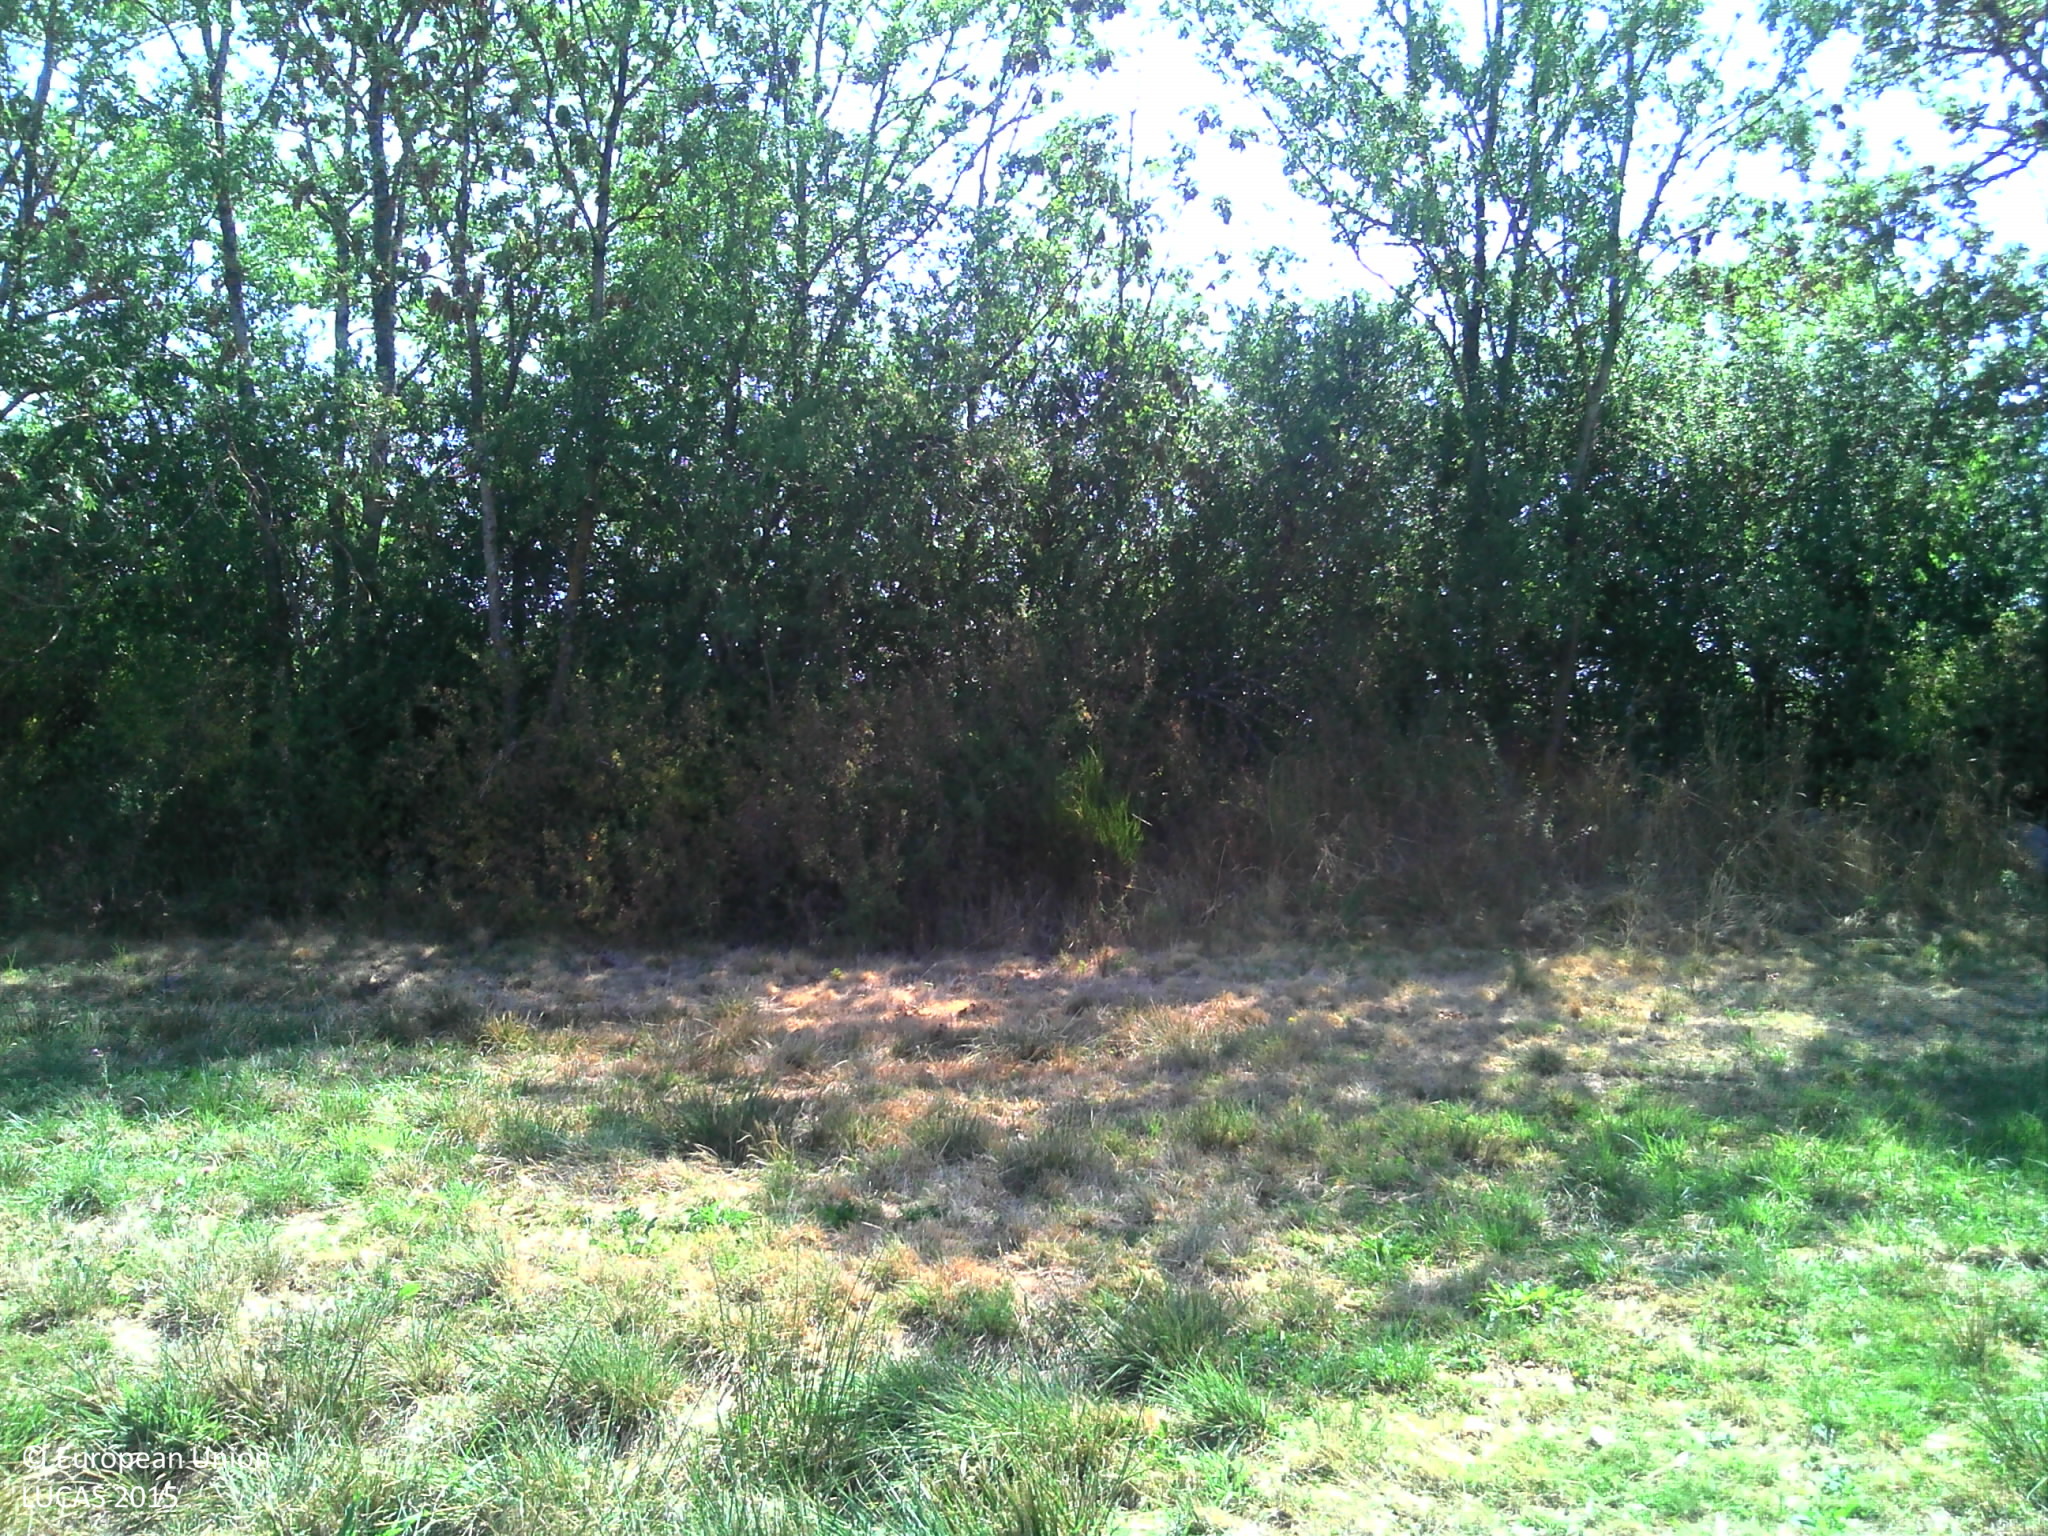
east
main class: Grassland
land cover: Grassland without tree/shrub cover
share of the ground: > 75 %
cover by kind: herbaceous plants 100 %
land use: Agriculture (excluding fallow land and kitchen gardens)
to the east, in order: Grassland without tree/shrub cover; Abandoned hedges; Dry stone walls; Barley
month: August
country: FR
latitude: 45.2139
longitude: 3.8023
